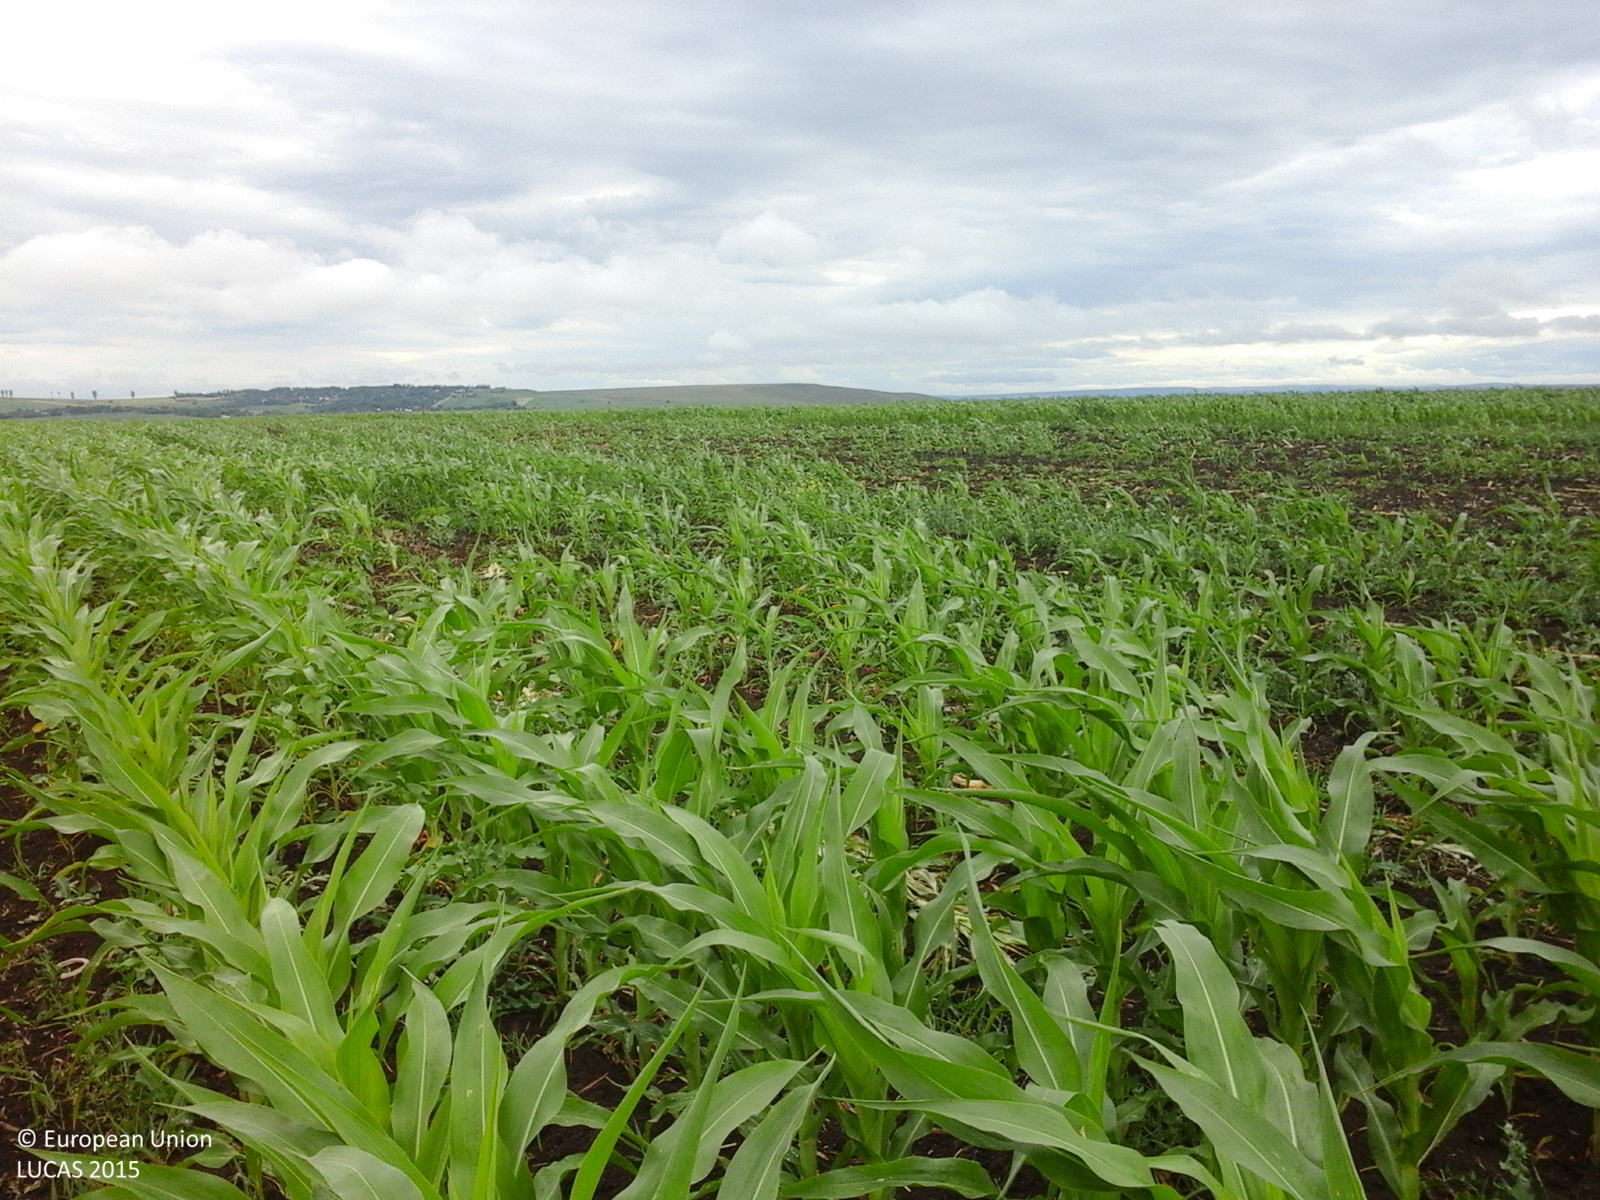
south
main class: Cropland
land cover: Maize
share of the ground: > 75 %
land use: Agriculture (excluding fallow land and kitchen gardens)
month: June
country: RO
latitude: 47.2254
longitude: 26.8563
